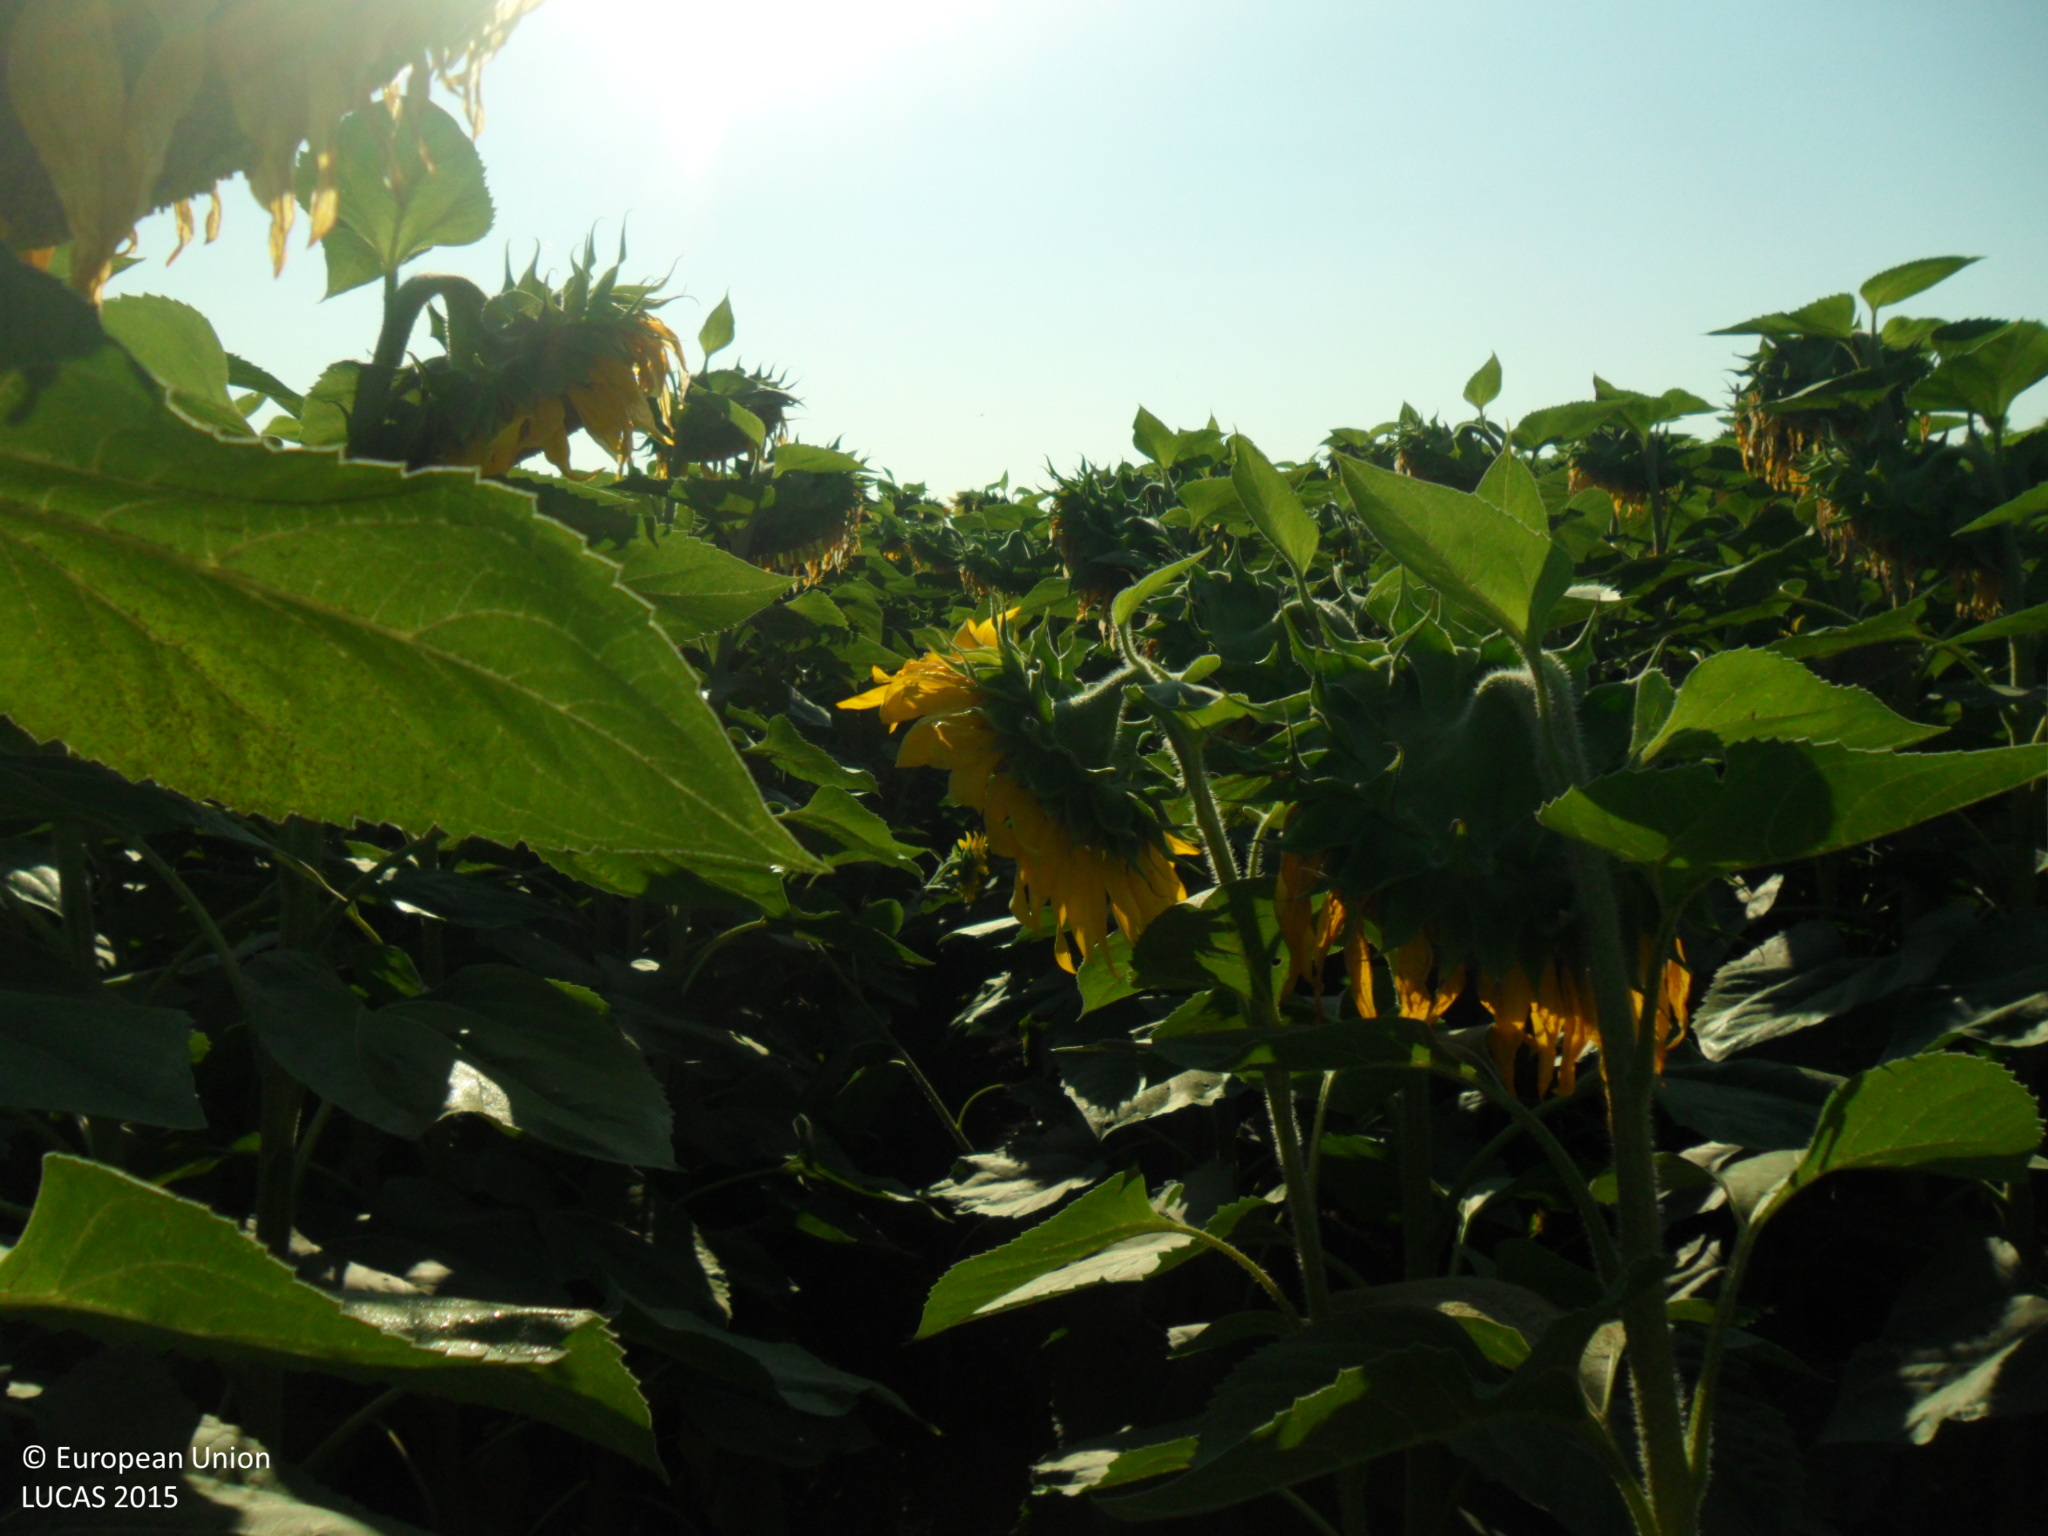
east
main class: Cropland
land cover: Sunflower
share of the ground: > 75 %
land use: Agriculture (excluding fallow land and kitchen gardens)
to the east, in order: Sunflower; Grassland without tree/shrub cover; Tracks; Grassland without tree/shrub cover
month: July
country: BG
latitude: 43.3194
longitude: 27.1226
